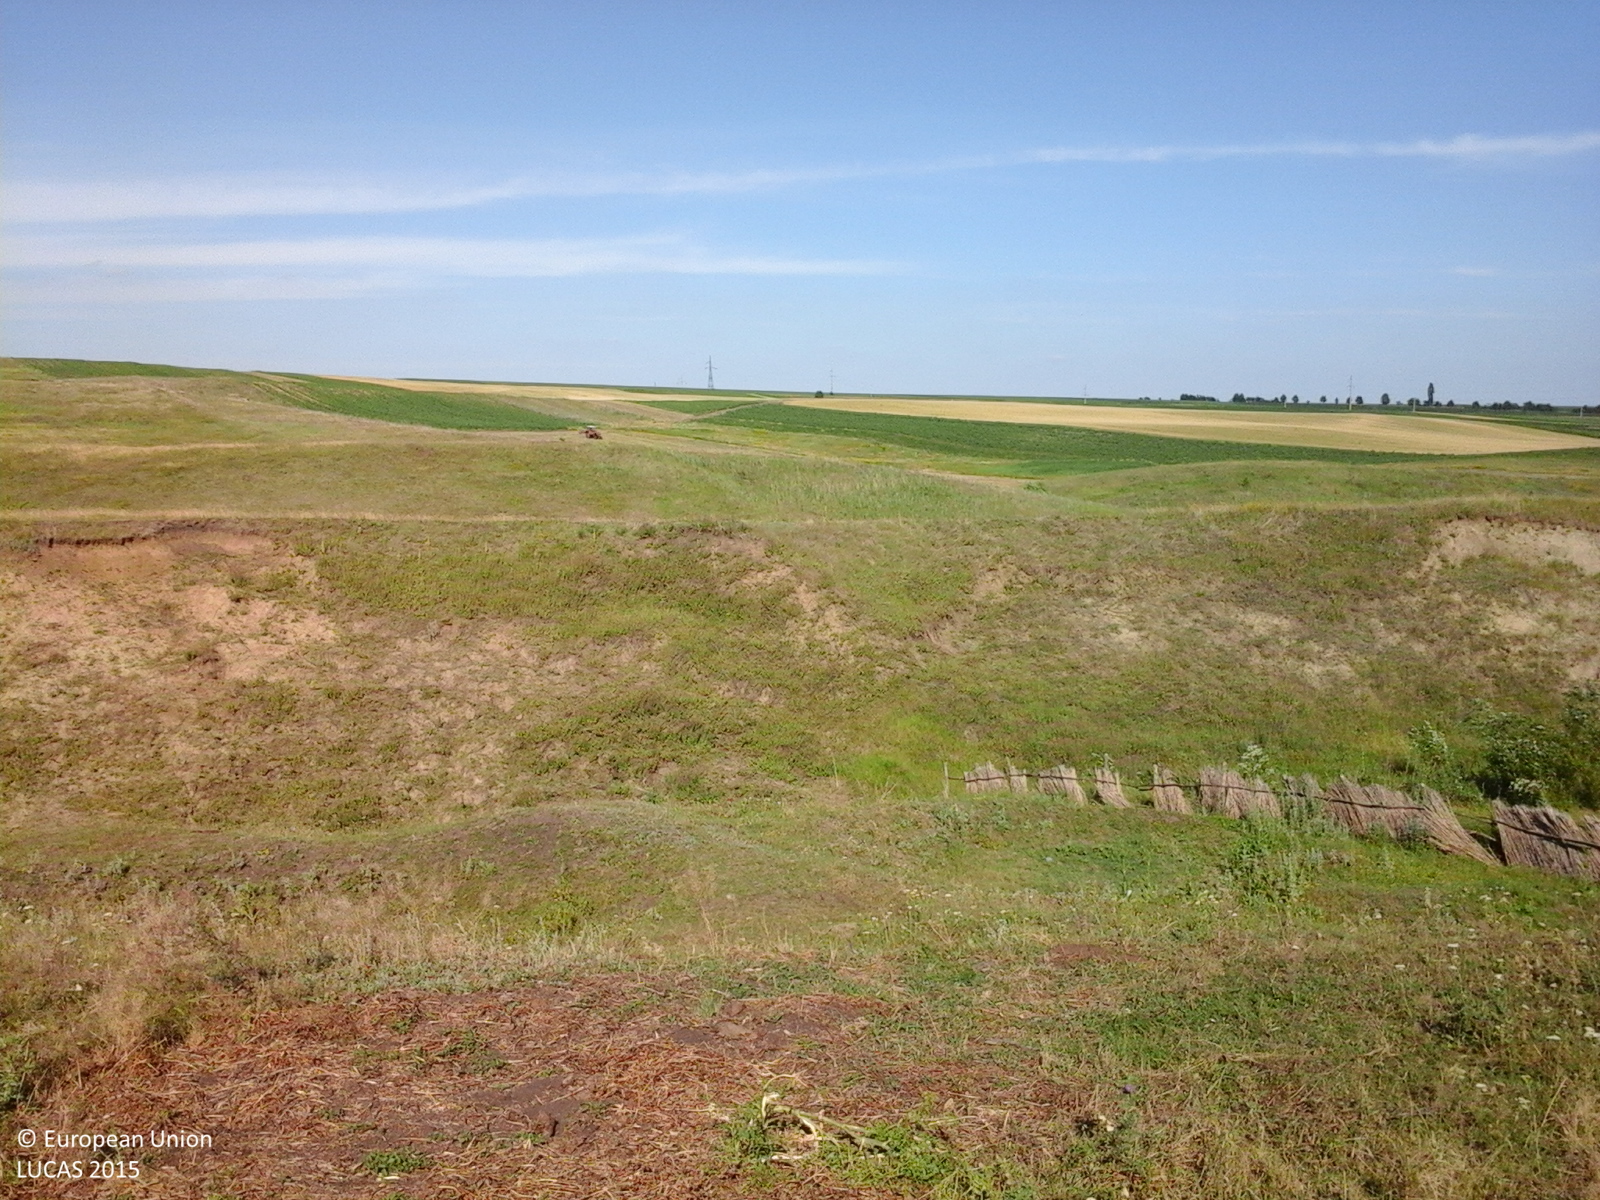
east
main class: Grassland
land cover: Grassland without tree/shrub cover
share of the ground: > 75 %
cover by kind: herbaceous plants 100 %
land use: Agriculture (excluding fallow land and kitchen gardens)
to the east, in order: Grassland without tree/shrub cover; Rivers and streams; Grassland without tree/shrub cover; Spontaneously vegetated surfaces; Grassland without tree/shrub cover
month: June
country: RO
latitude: 48.0532
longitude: 26.9702
